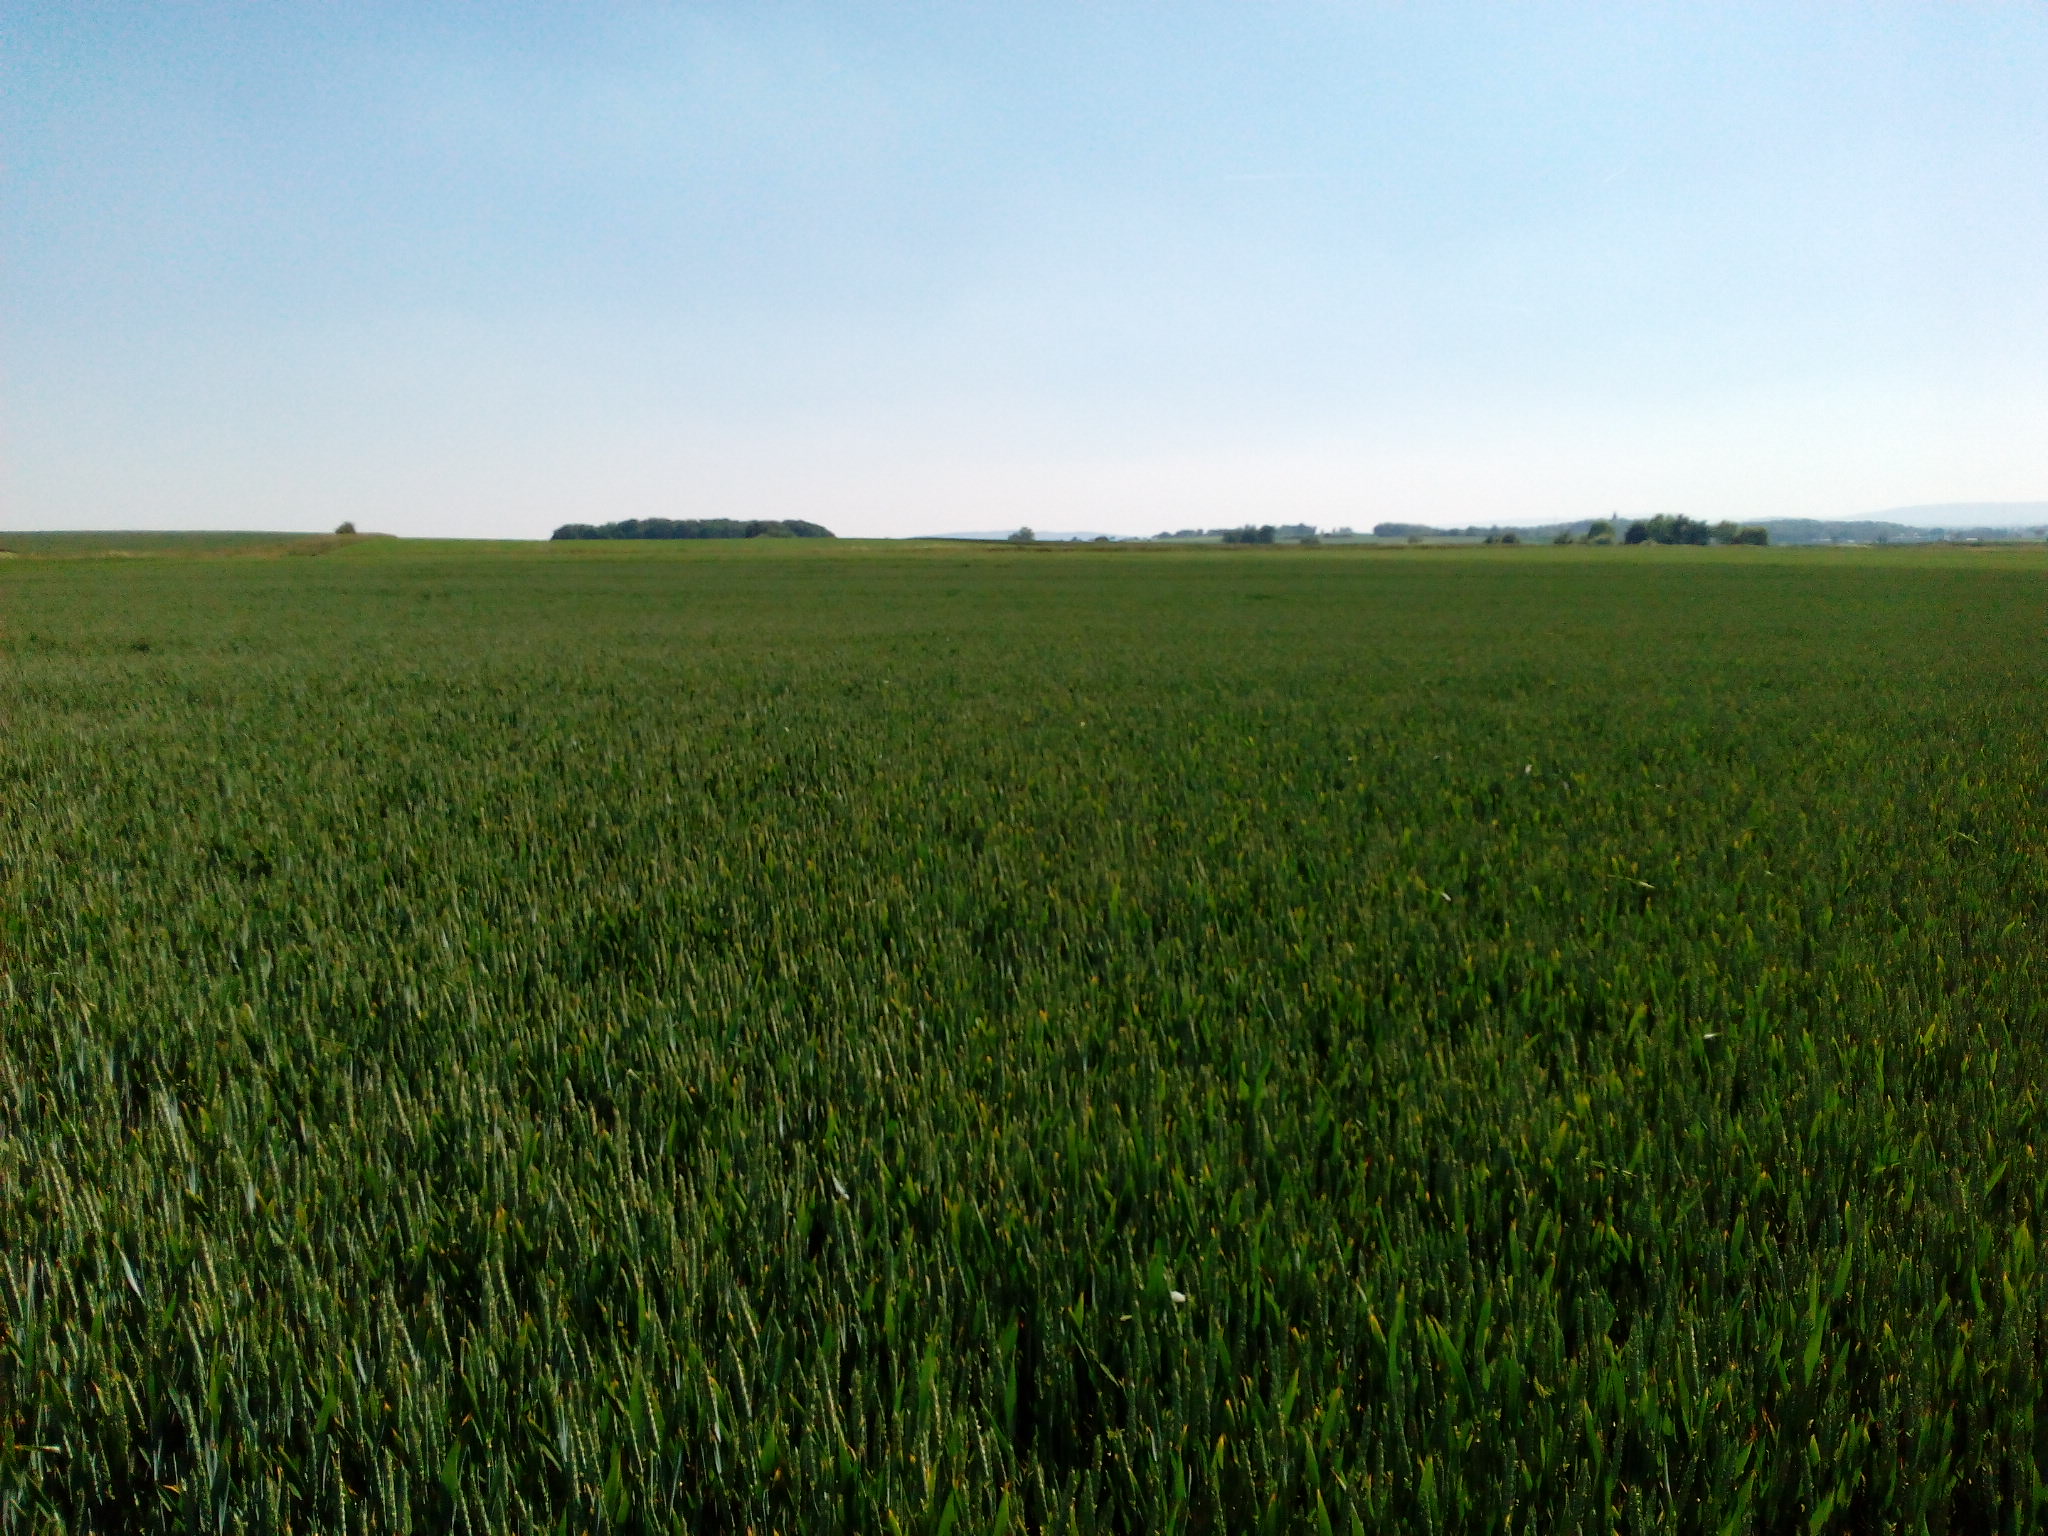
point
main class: Cropland
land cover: Common wheat
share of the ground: > 75 %
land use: Agriculture (excluding fallow land and kitchen gardens)
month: June
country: DE
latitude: 52.2696
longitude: 9.8975
